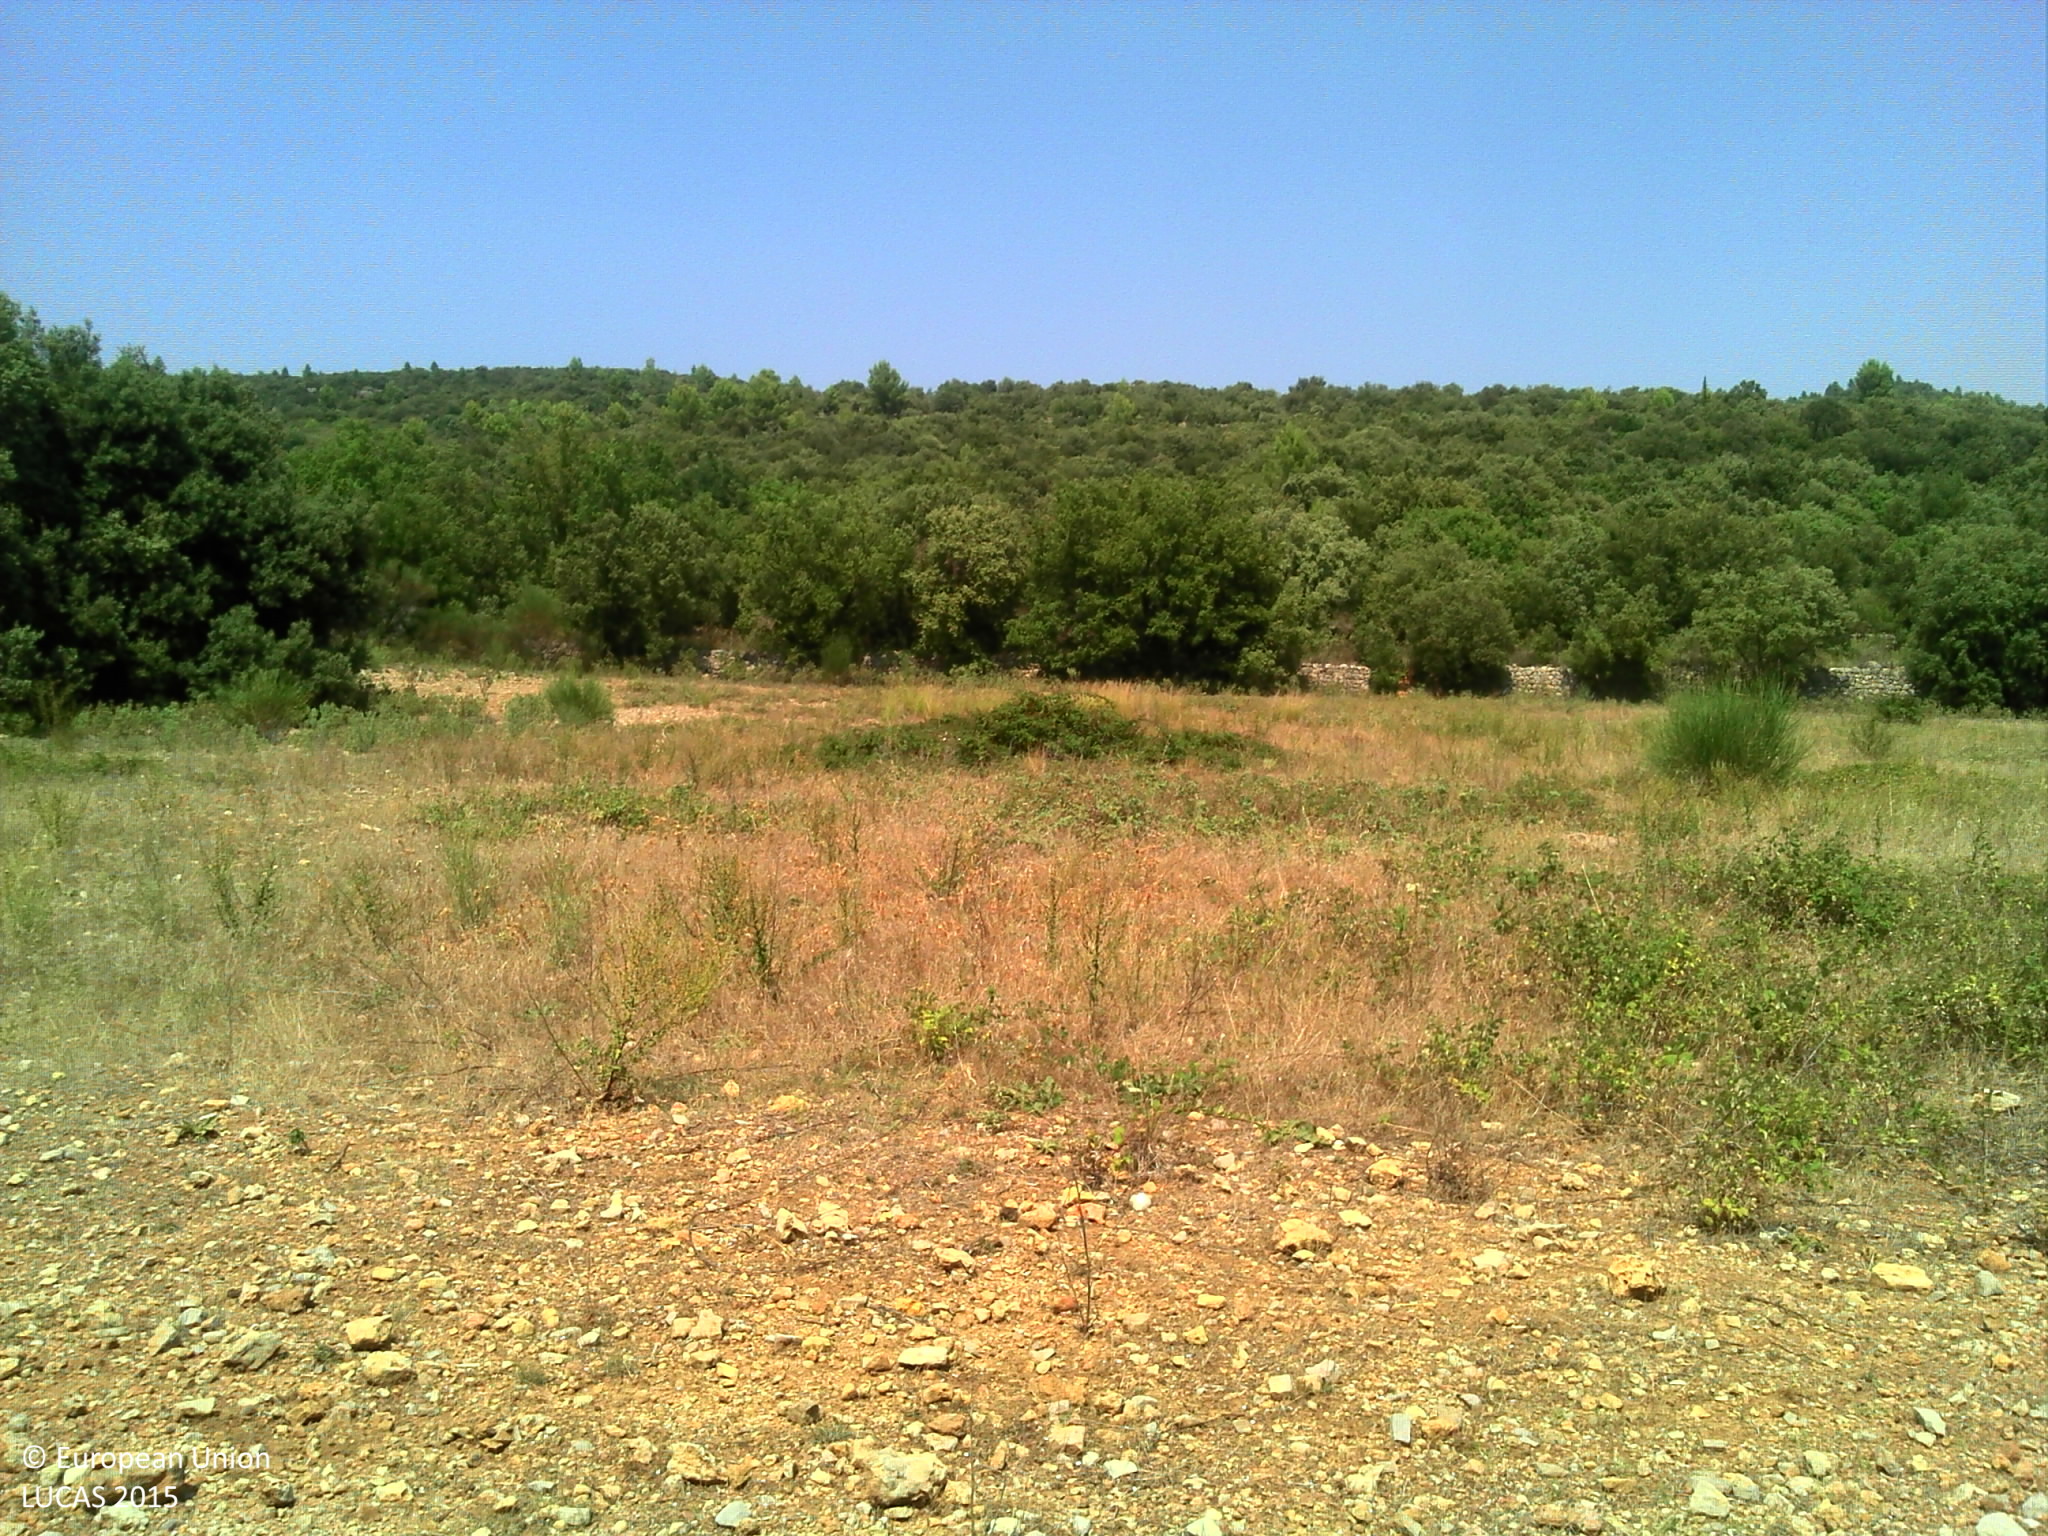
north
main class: Grassland
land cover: Spontaneously vegetated surfaces
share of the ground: > 75 %
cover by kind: herbaceous plants 75 %, unconsolidated bare surface 20 %, shrubs 5 %
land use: Semi-natural and natural areas not in use
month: August
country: FR
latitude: 43.5977
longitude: 6.2800
